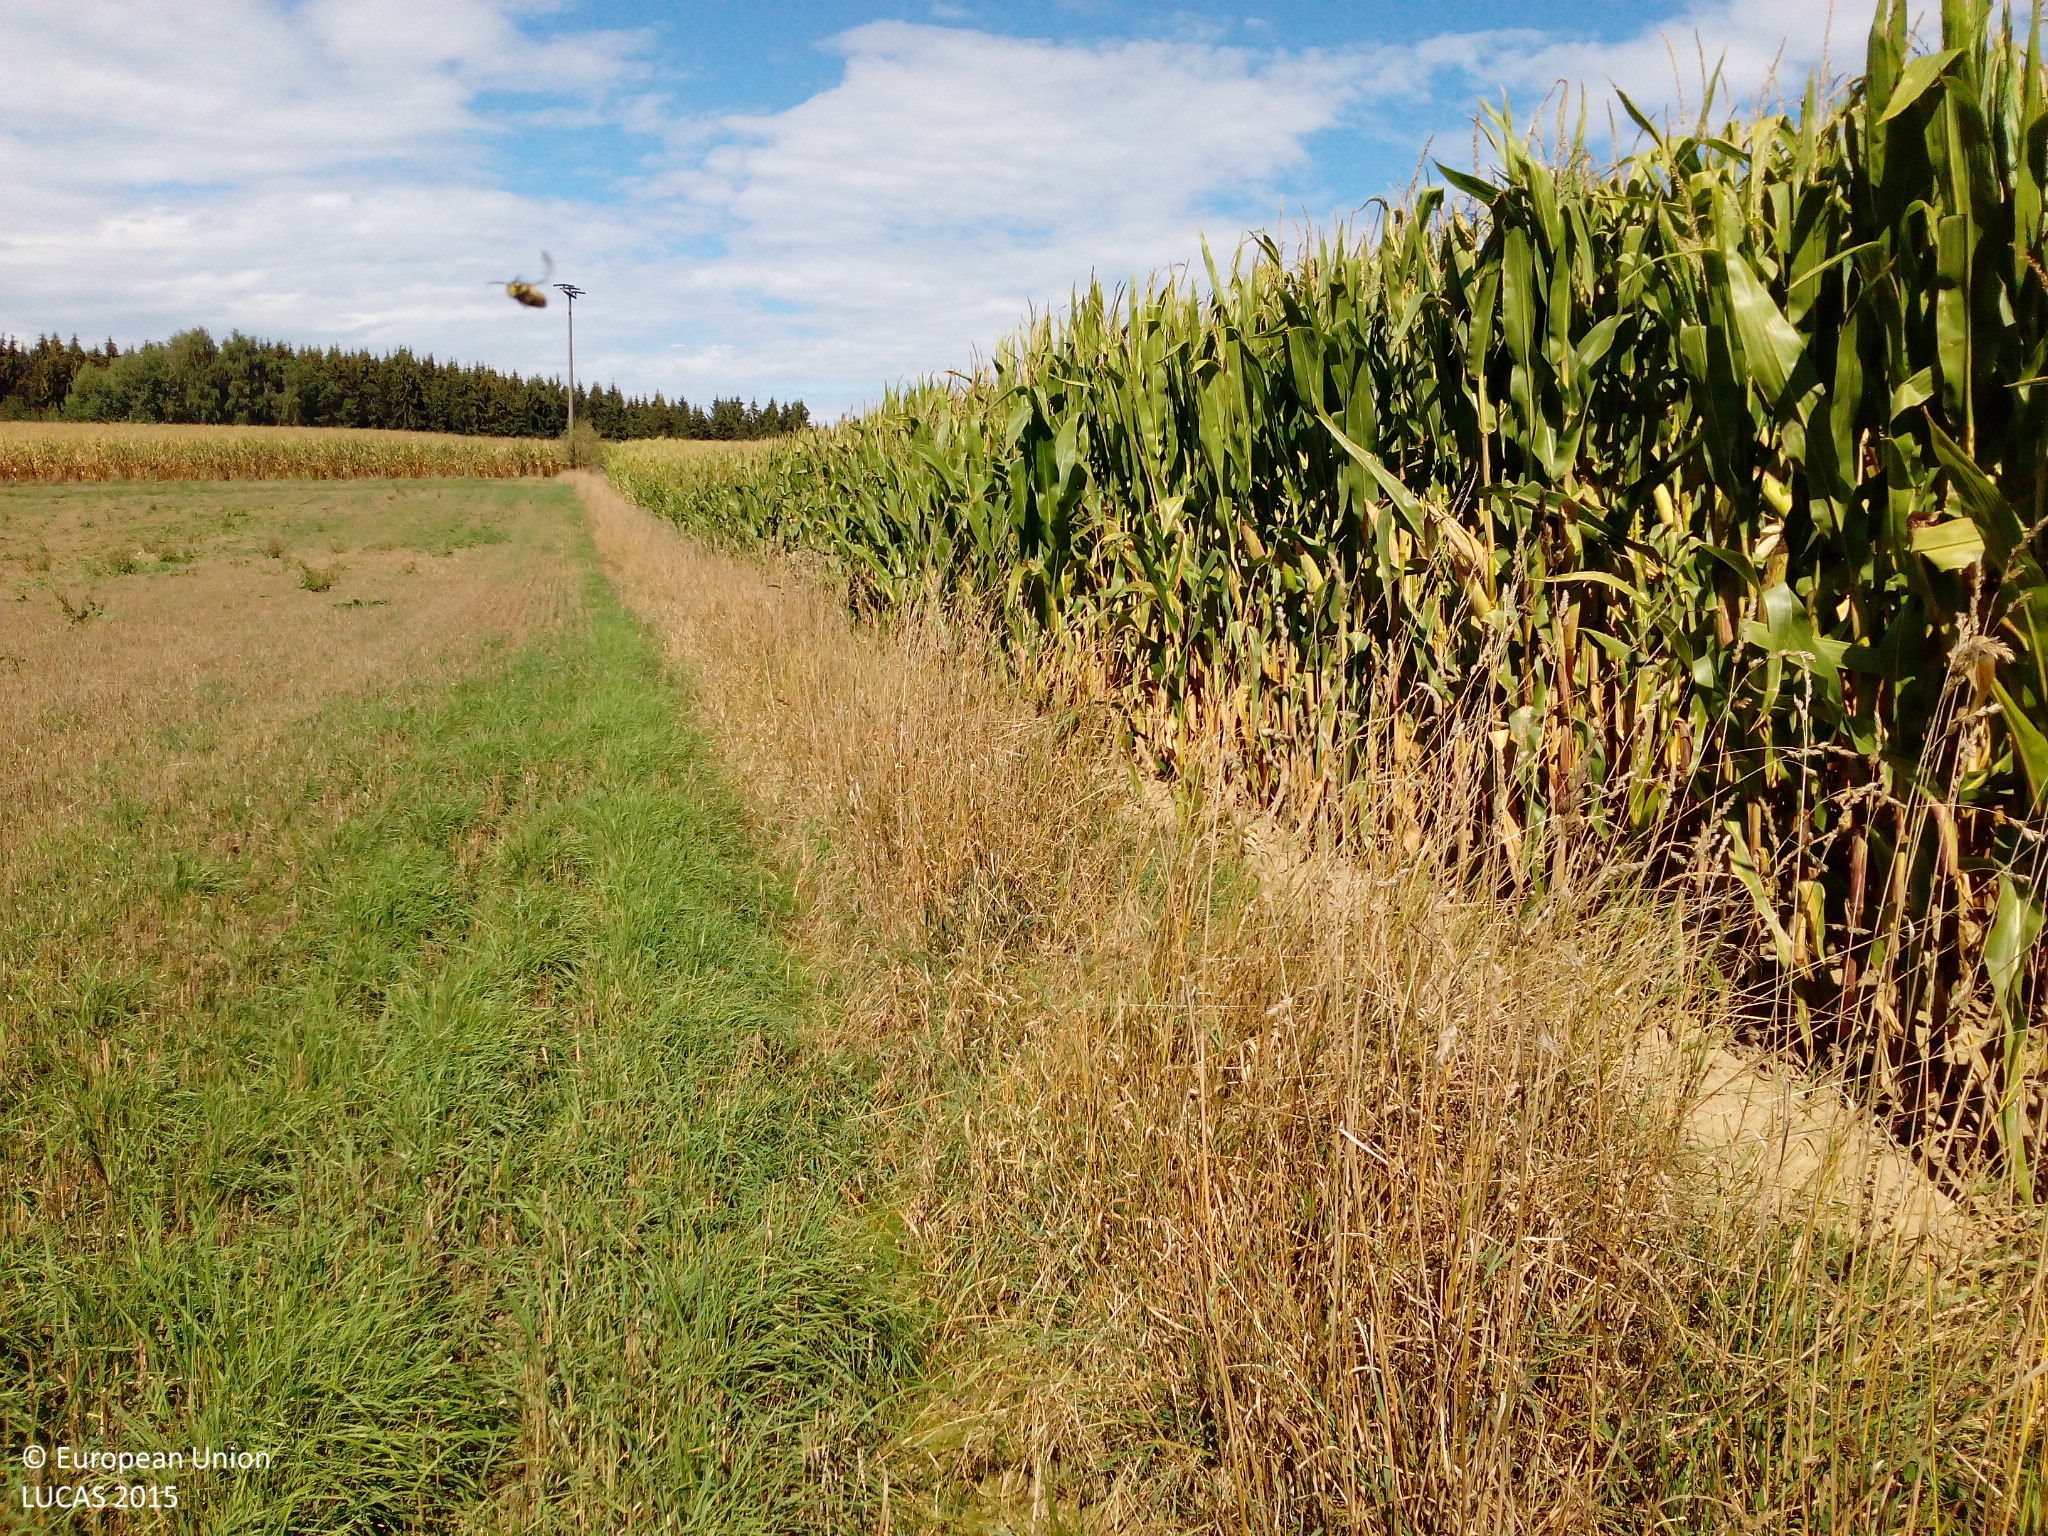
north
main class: Cropland
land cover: Maize
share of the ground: > 75 %
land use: Agriculture (excluding fallow land and kitchen gardens)
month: September
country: DE
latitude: 48.3842
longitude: 12.0650
